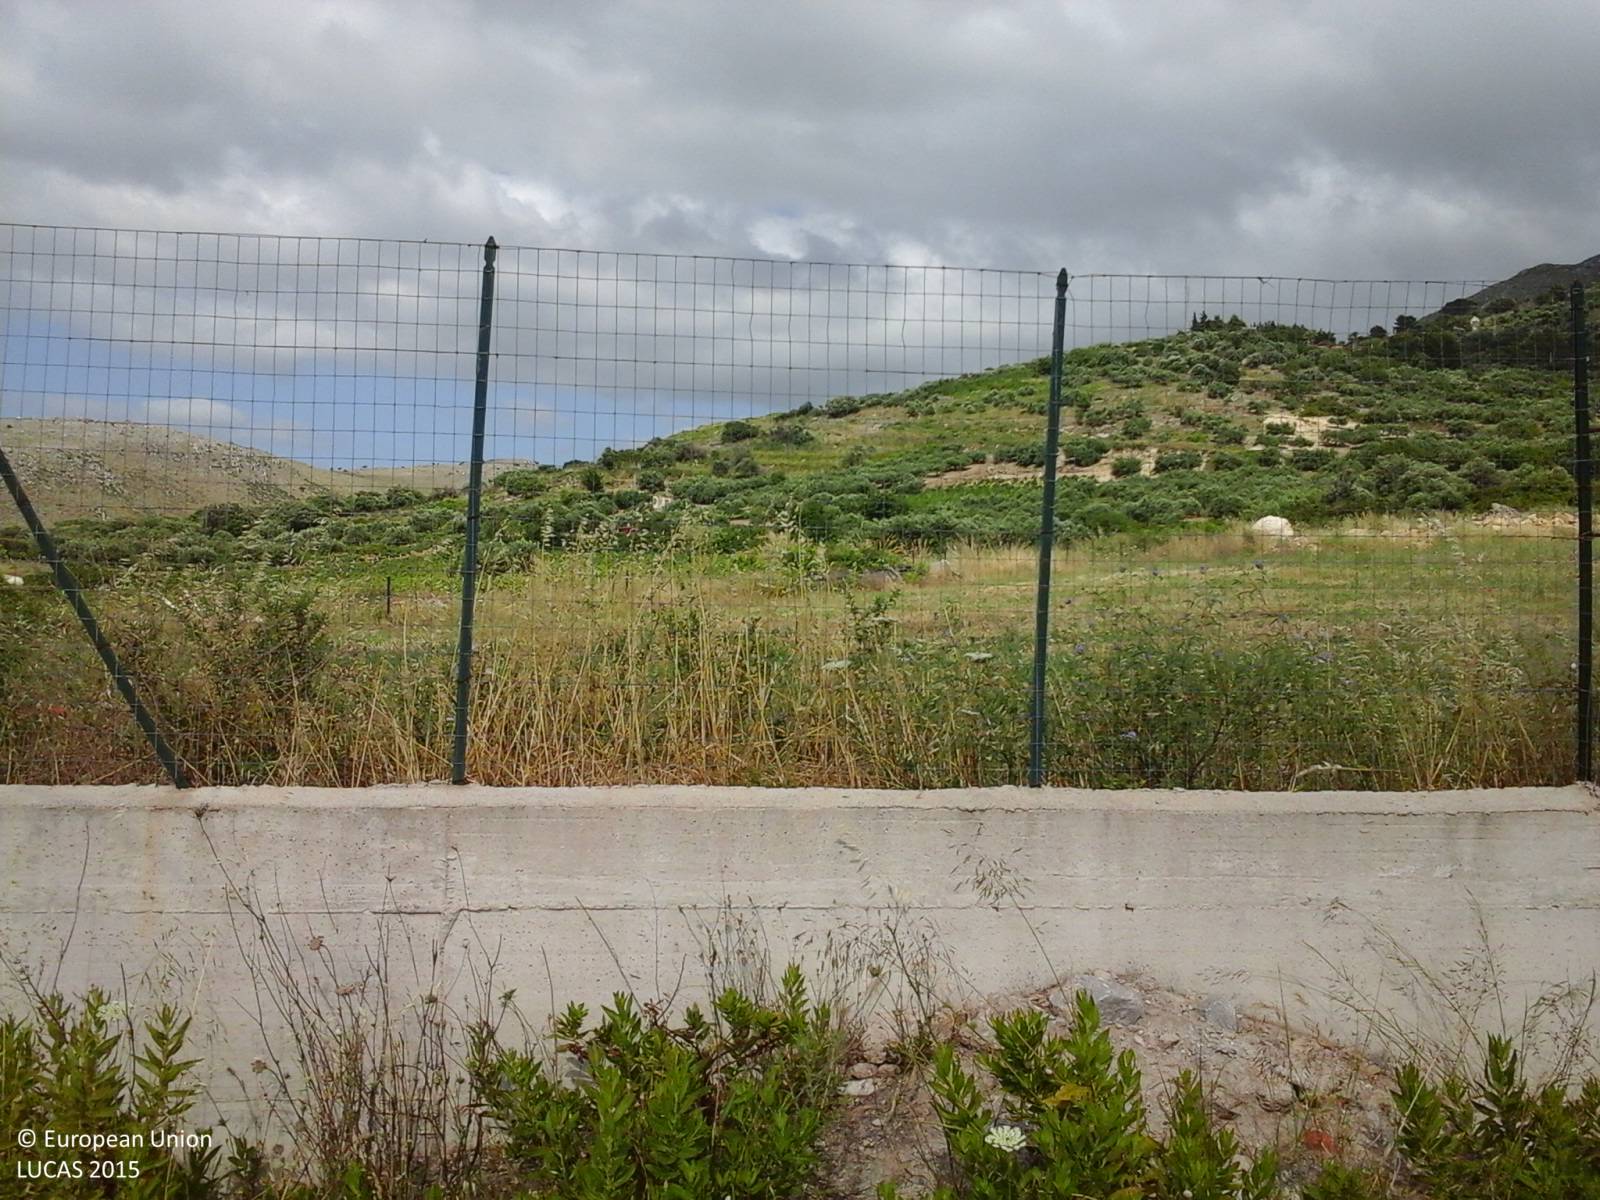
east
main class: Cropland
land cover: Vineyards
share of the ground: 25 - 50 %
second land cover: Olive groves
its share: 25 - 50 %
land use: Agriculture (excluding fallow land and kitchen gardens)
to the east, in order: Vineyards; Olive groves; Grassland without tree/shrub cover; Fences; Olive groves; Grassland without tree/shrub cover; Olive groves; Spontaneously vegetated surfaces; Fences; Tracks; Fences; Electric lines; Olive groves
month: June
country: IT
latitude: 38.0584
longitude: 13.1574
